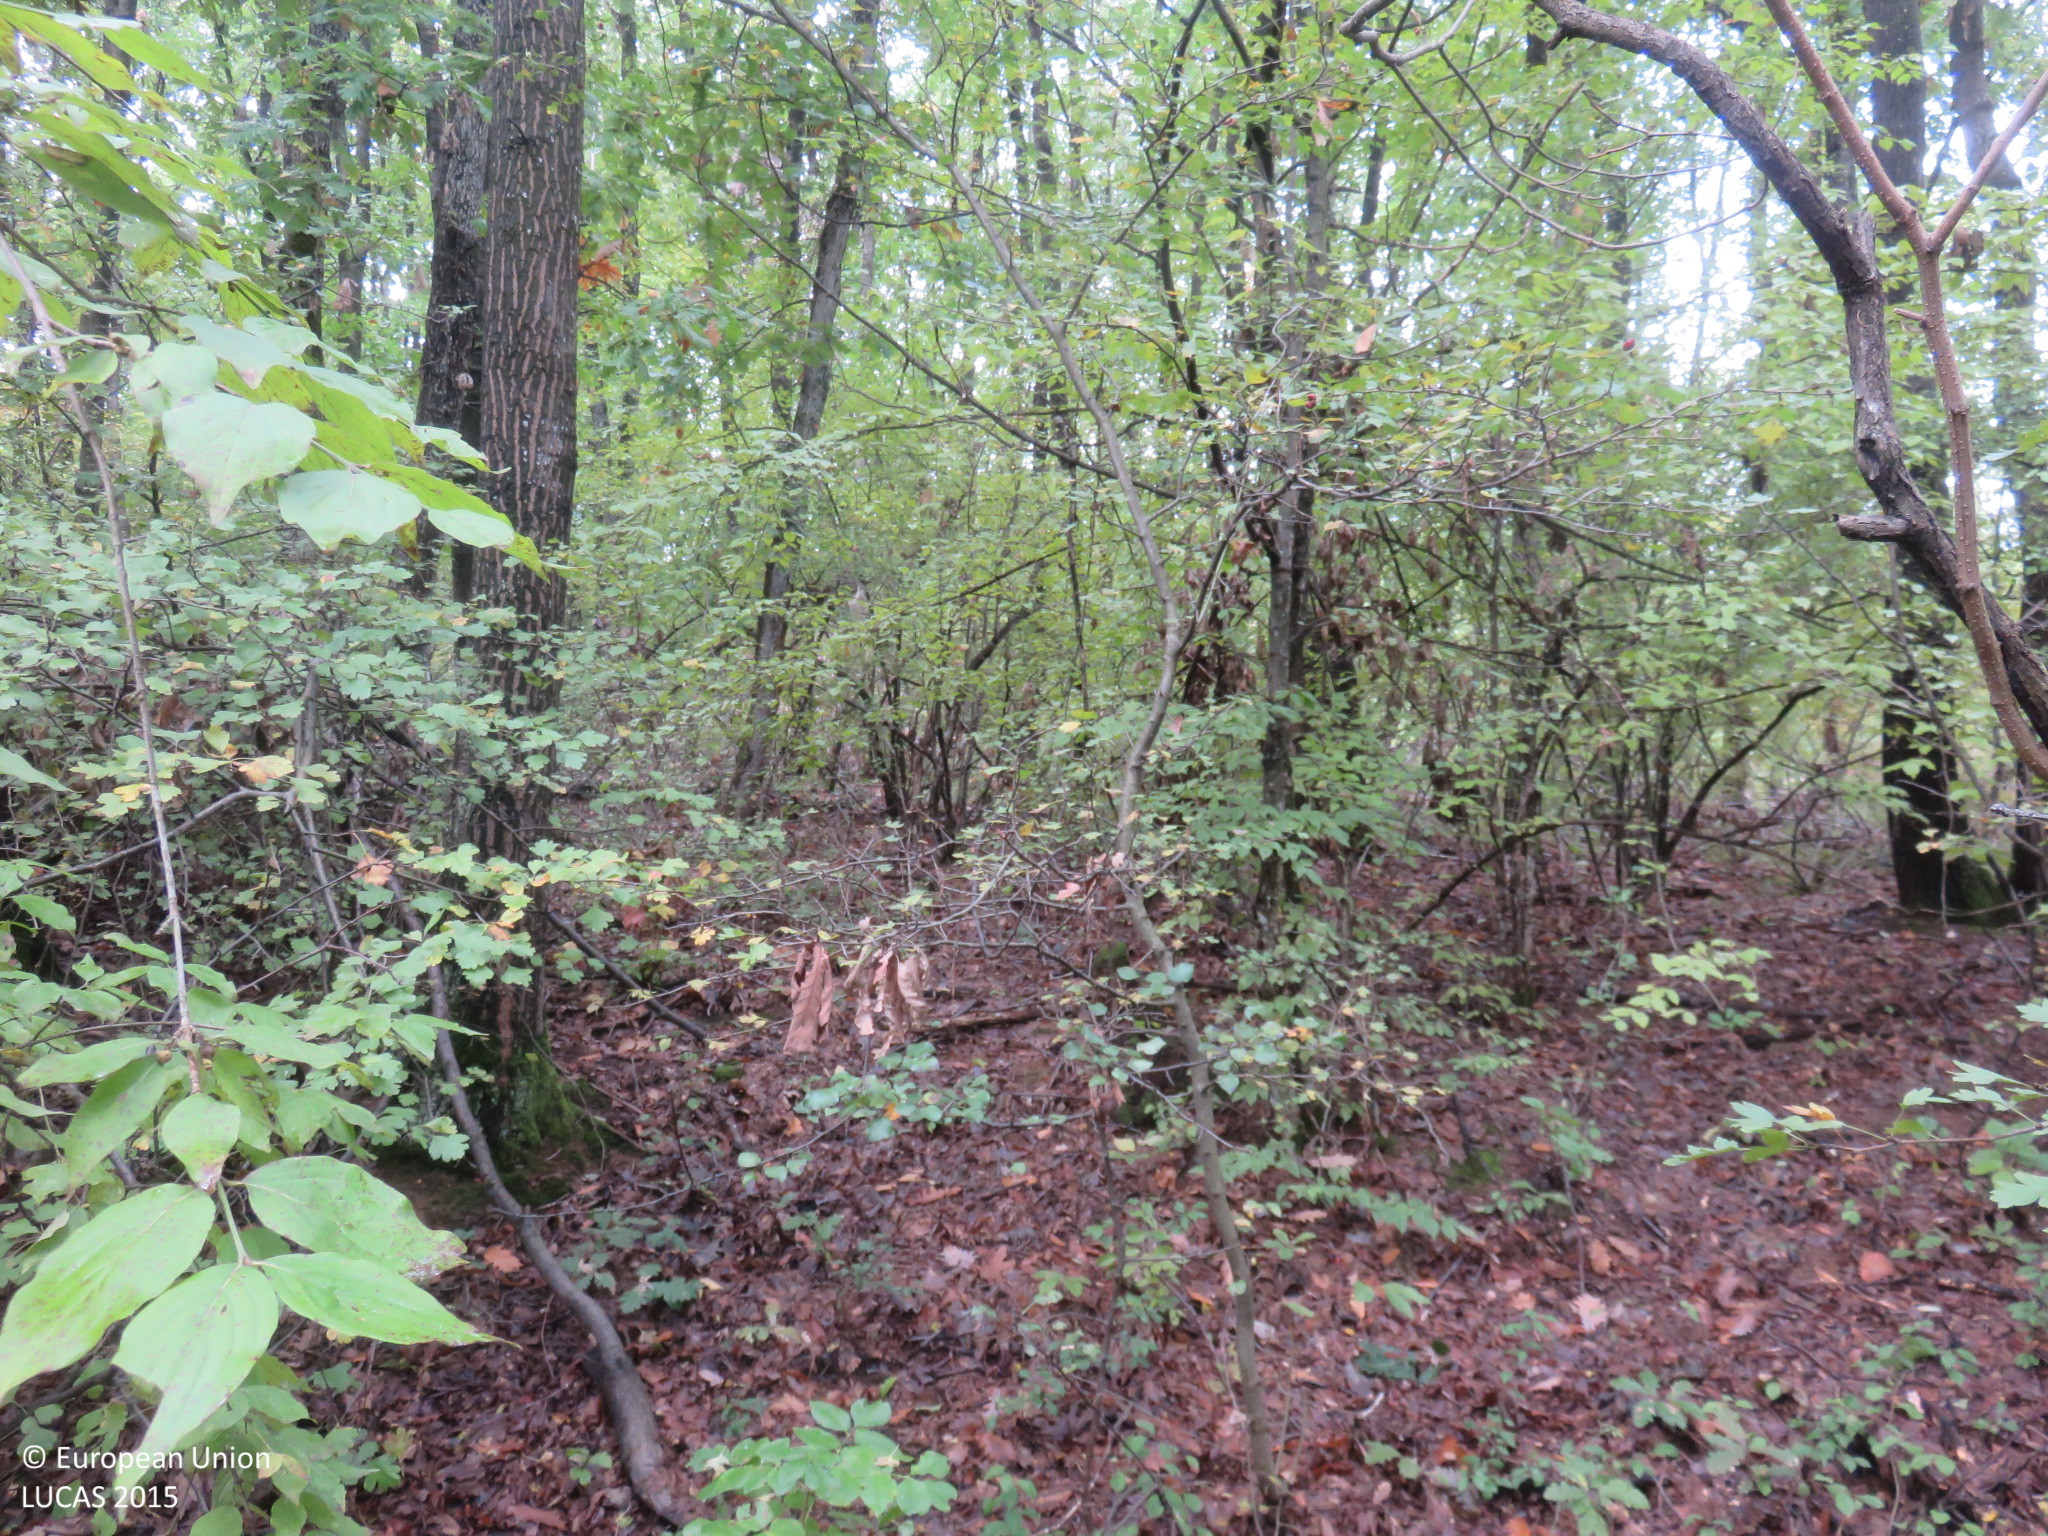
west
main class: Woodland
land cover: Broadleaved woodland
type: mesophytic deciduous forest
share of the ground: > 75 %
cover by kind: broadleaved forest trees 95 %, shrubs 5 %
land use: Forestry
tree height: < 5 m
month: October
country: BG
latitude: 43.0566
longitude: 25.2094
